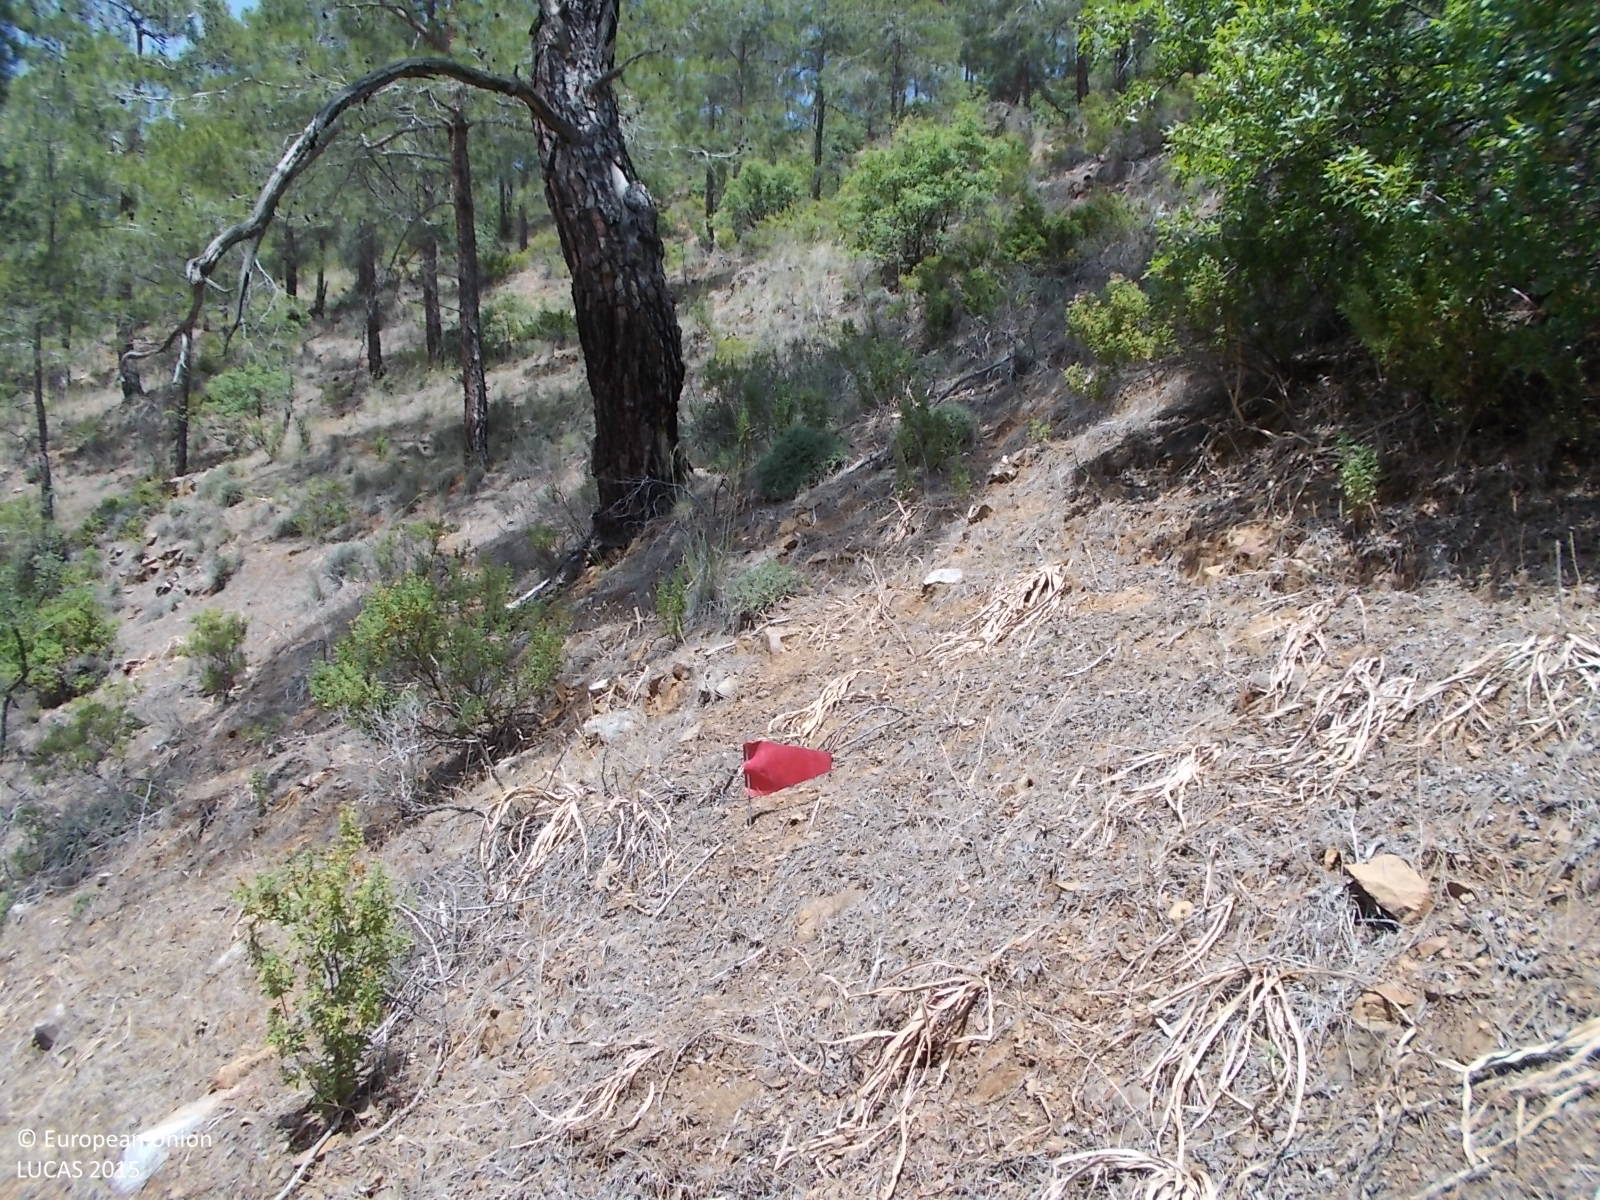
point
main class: Woodland
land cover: Pine dominated coniferous woodland
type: coniferous forest of the mediterranean region
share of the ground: > 75 %
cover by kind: coniferous forest trees 75 %, unconsolidated bare surface 15 %, shrubs 10 %
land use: Semi-natural and natural areas not in use
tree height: > 5 m
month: May
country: CY
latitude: 35.1158
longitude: 32.6918
